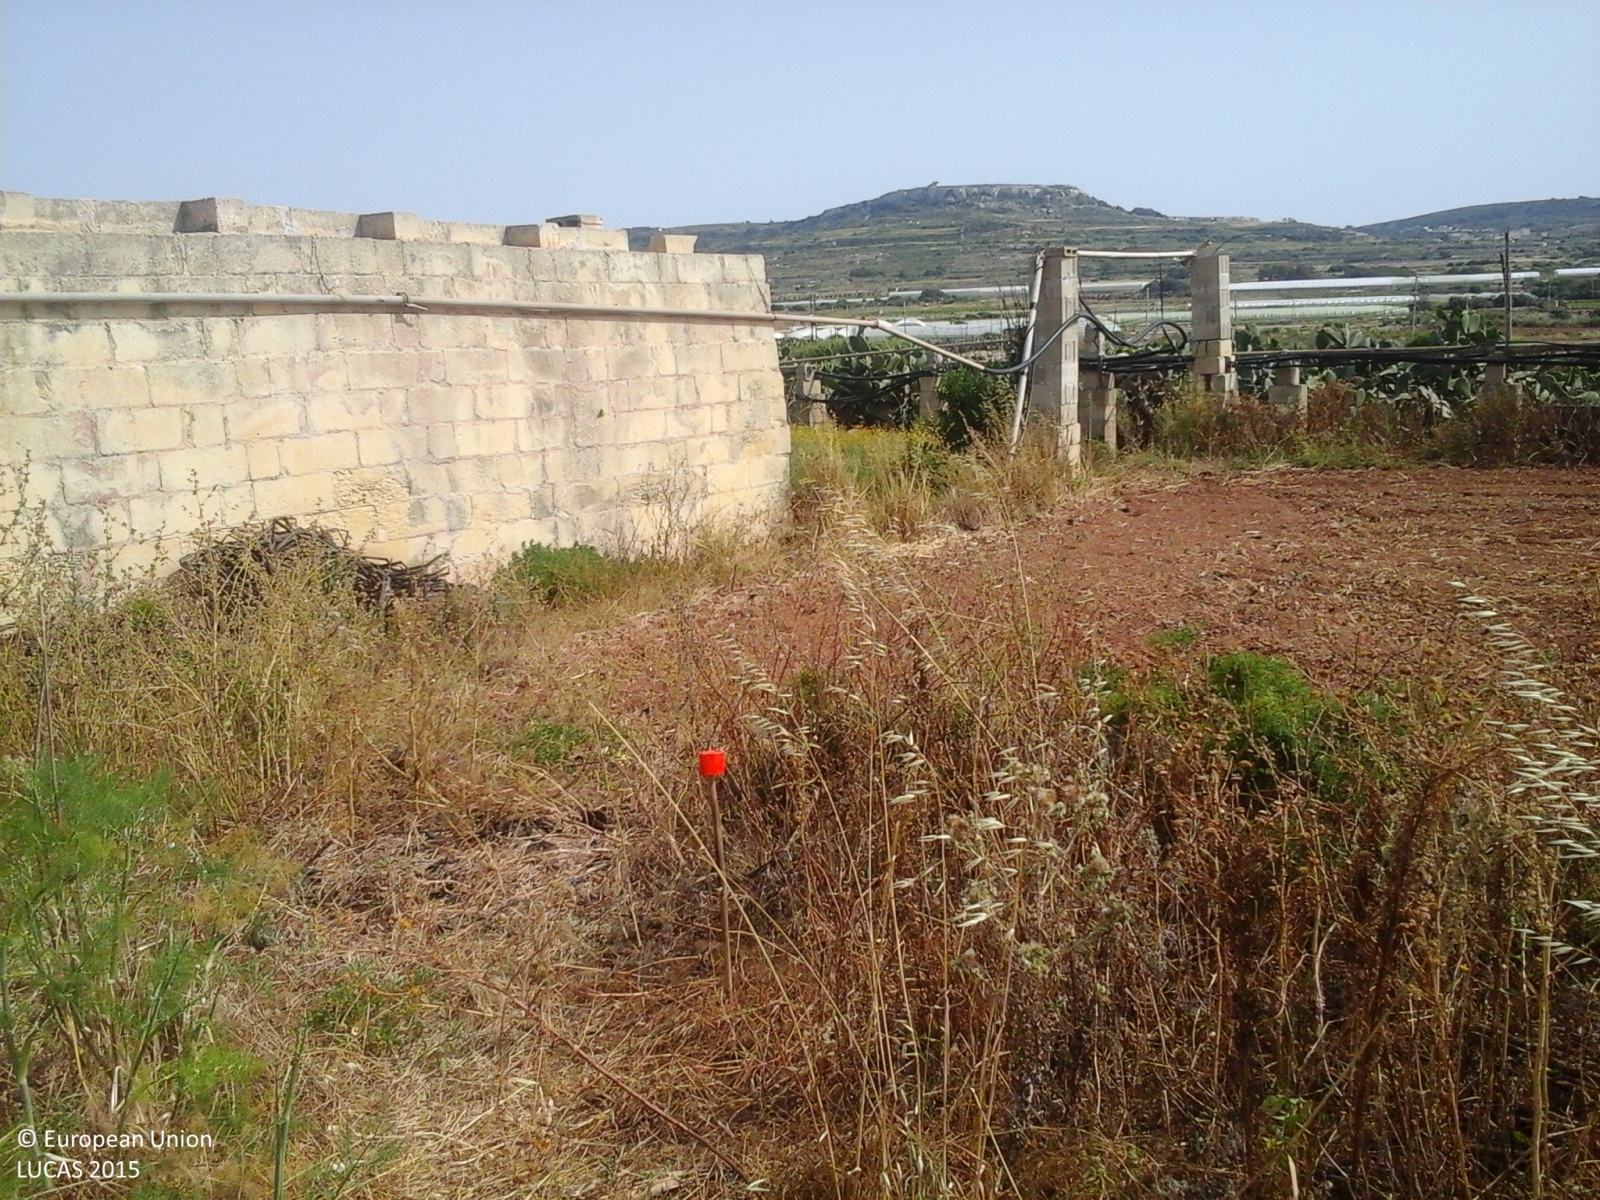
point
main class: Grassland
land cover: Spontaneously vegetated surfaces
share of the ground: 25 - 50 %
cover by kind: herbaceous plants 50 %, unconsolidated bare surface 30 %
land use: Agriculture (excluding fallow land and kitchen gardens)
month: May
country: MT
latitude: 35.9189
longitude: 14.3593
